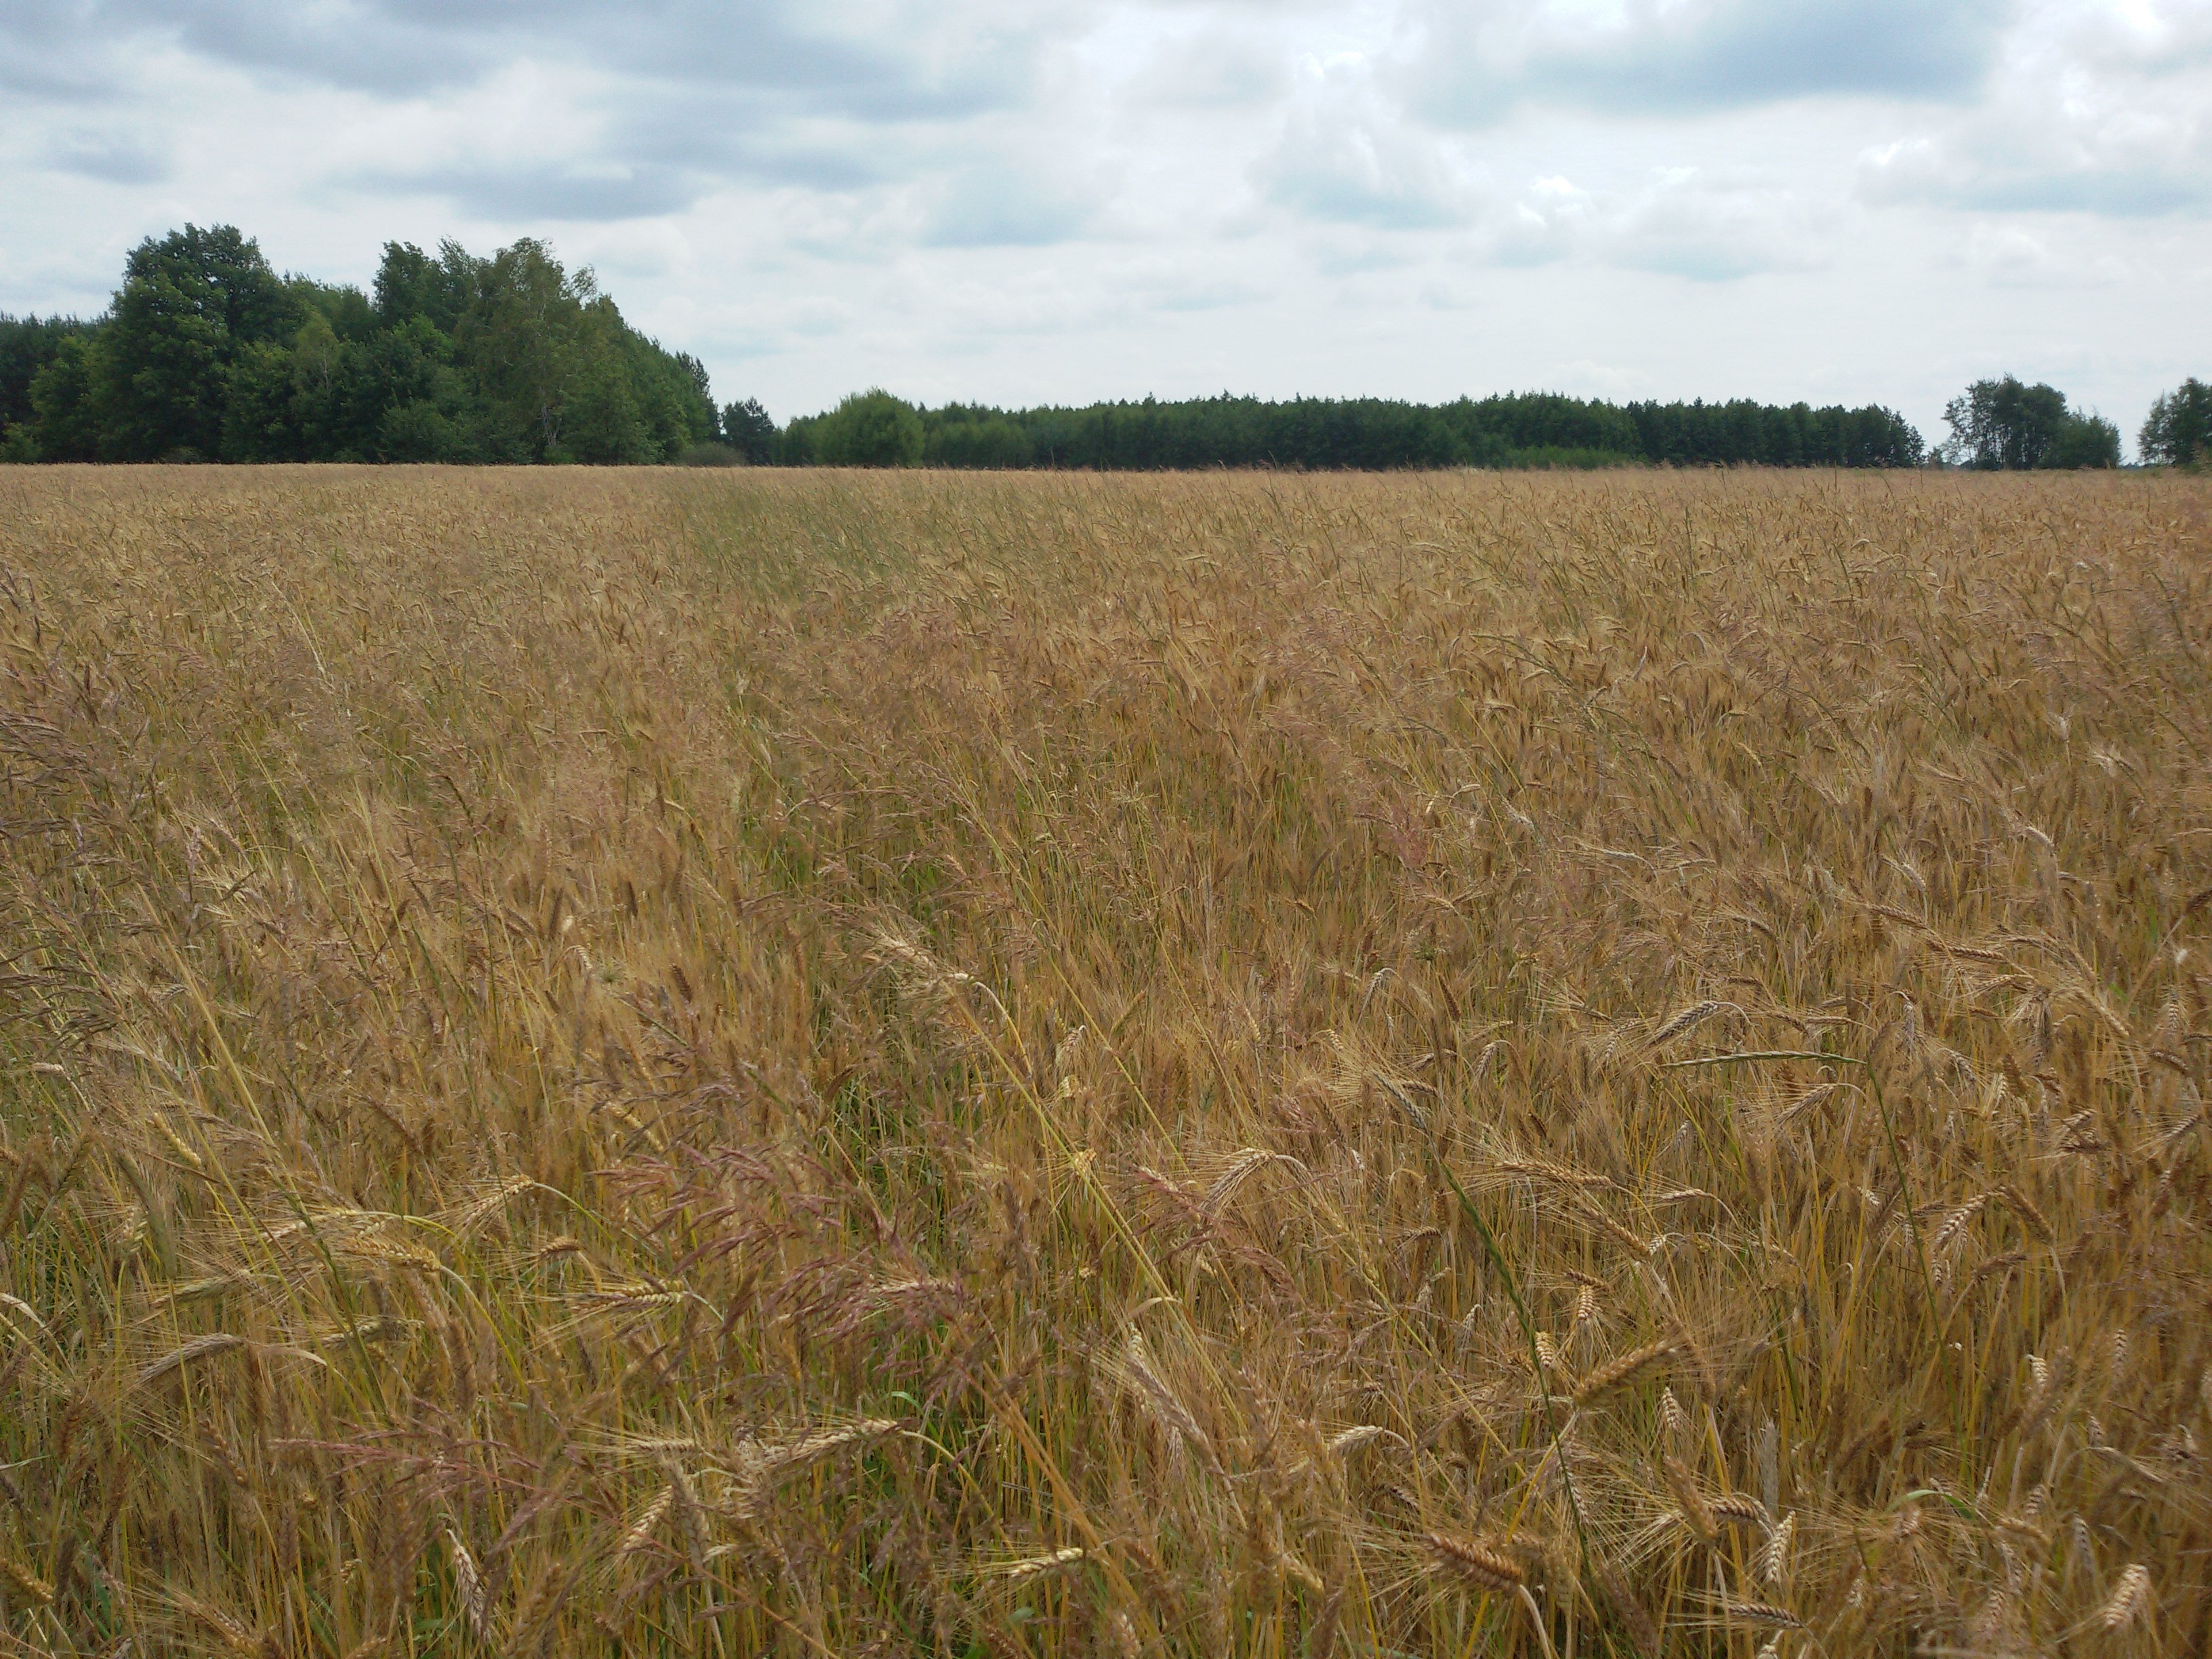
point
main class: Cropland
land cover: Triticale
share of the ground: > 75 %
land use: Agriculture (excluding fallow land and kitchen gardens)
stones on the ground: < 10 %
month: July
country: PL
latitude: 51.8881
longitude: 22.9030
